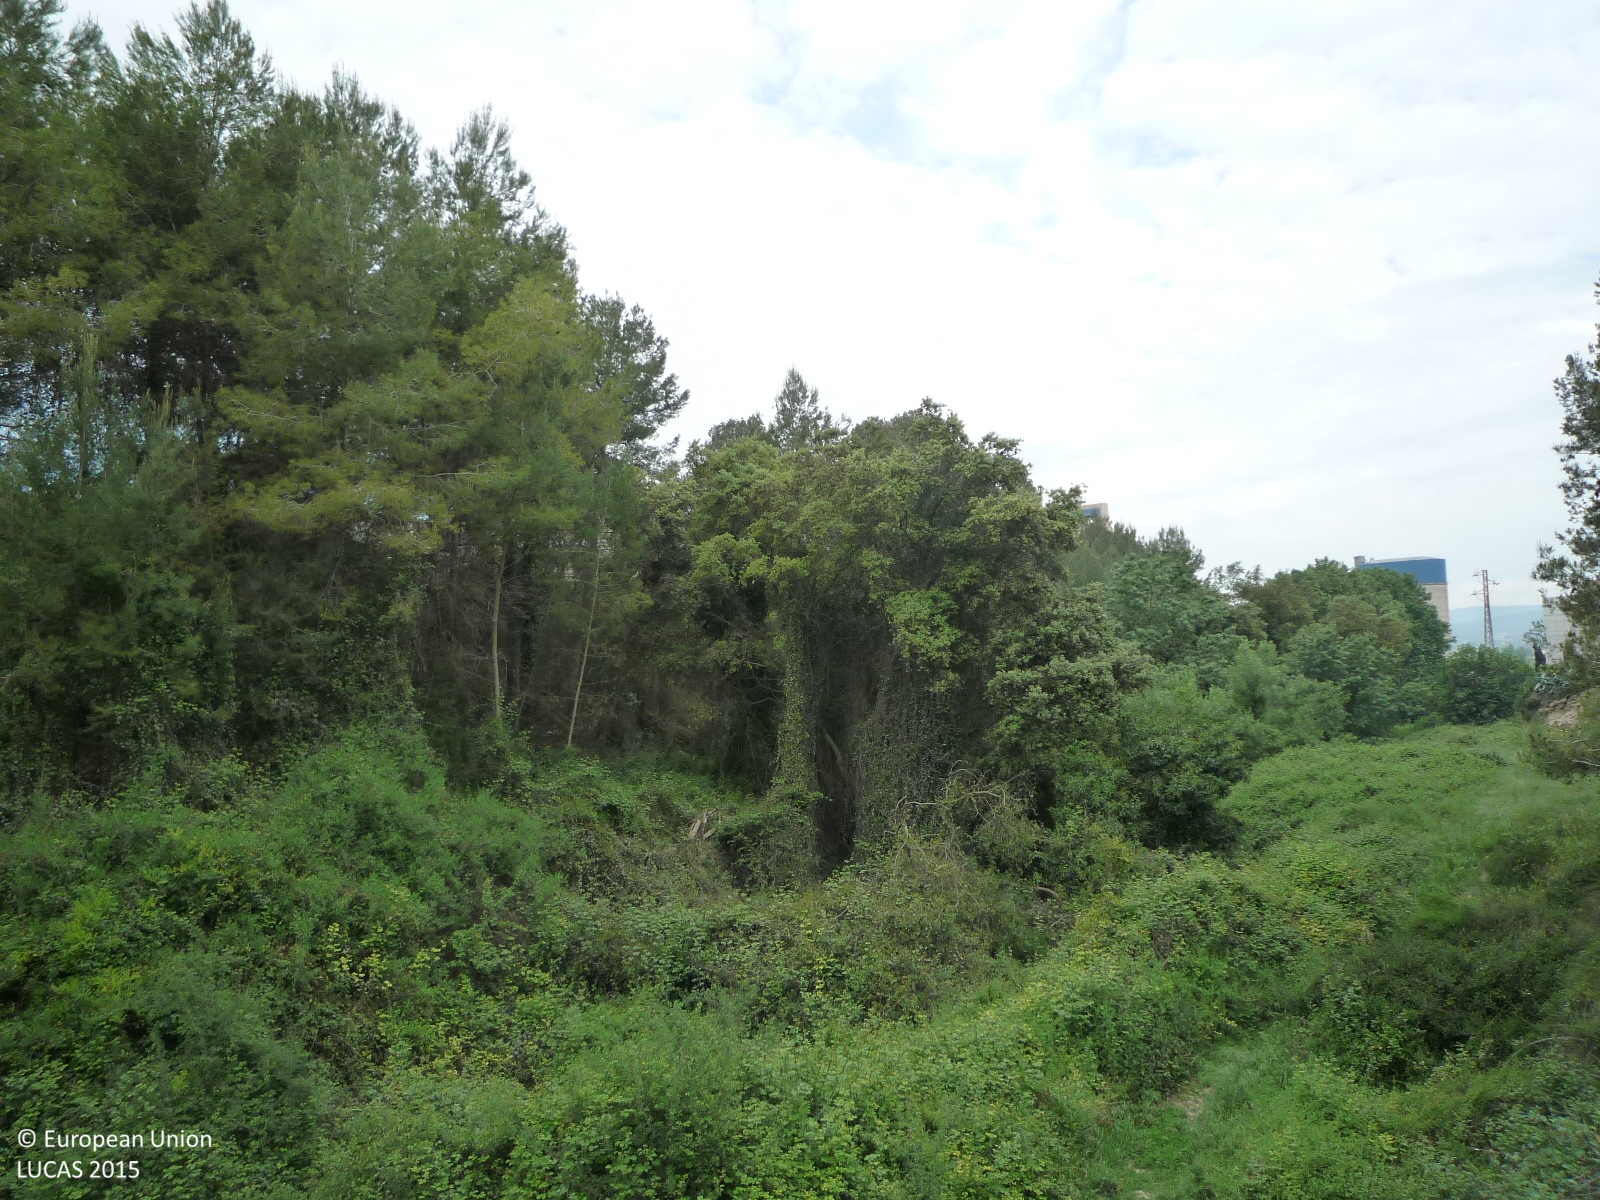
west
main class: Woodland
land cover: Pine dominated mixed woodland
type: coniferous forest of the mediterranean region
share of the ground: > 75 %
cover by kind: coniferous forest trees 60 %, broadleaved forest trees 35 %, shrubs 5 %
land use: Semi-natural and natural areas not in use
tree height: > 5 m
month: May
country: ES
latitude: 41.3117
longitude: 1.6680
